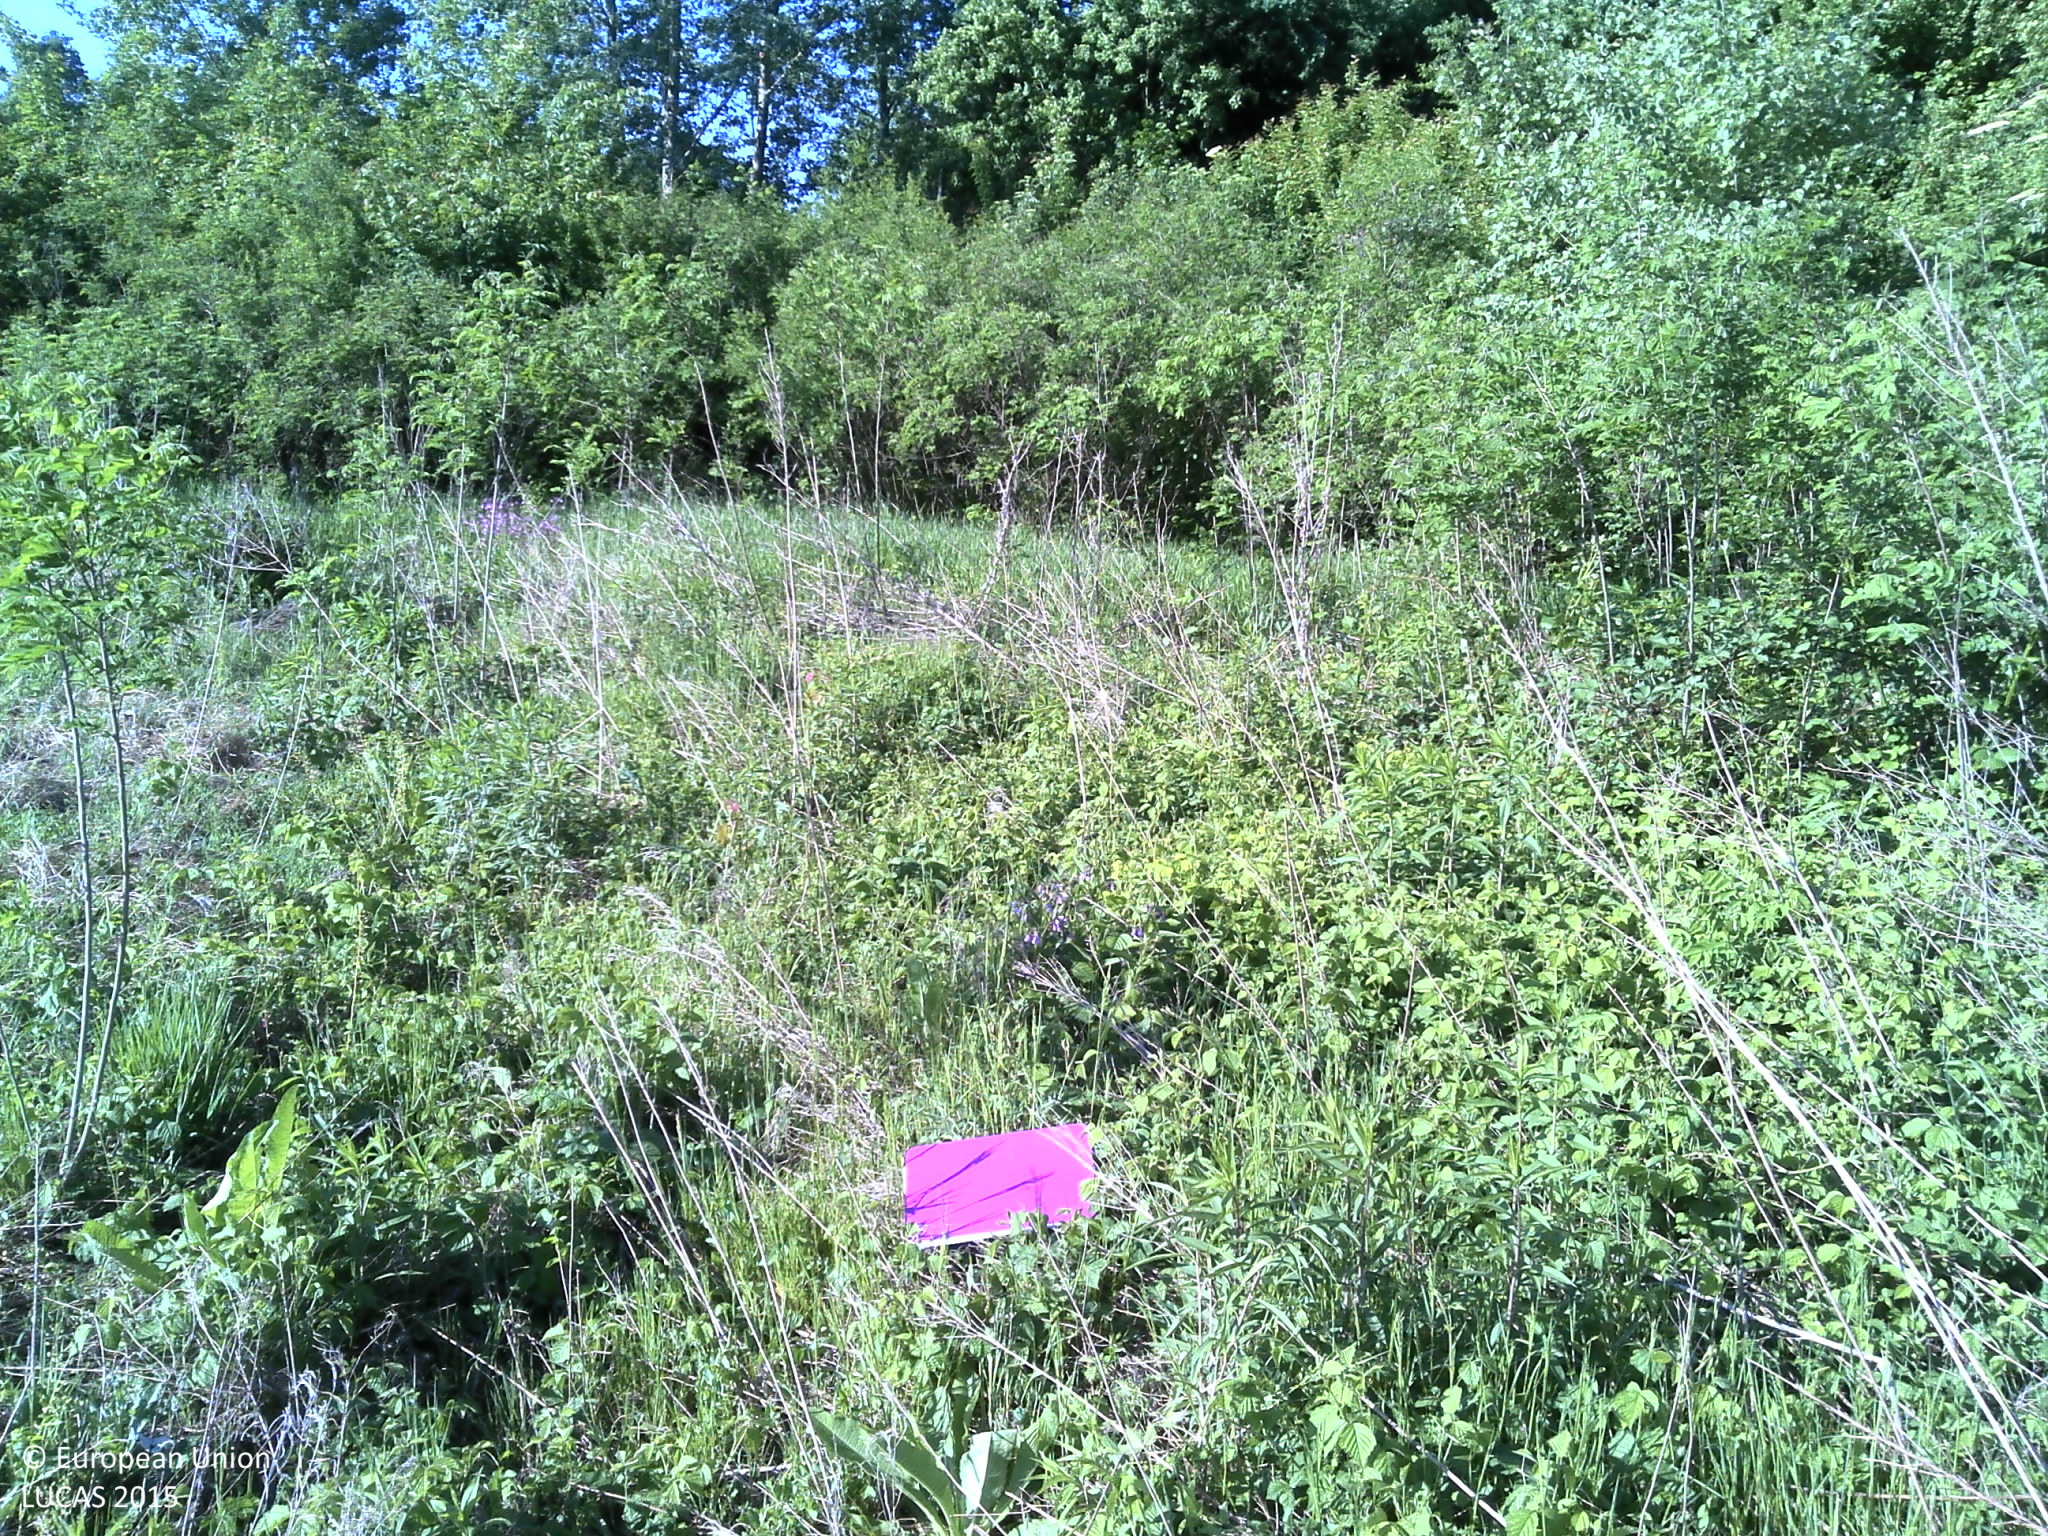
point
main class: Shrubland
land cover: Shrubland with sparse tree cover
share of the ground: > 75 %
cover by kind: shrubs 90 %, broadleaved forest trees 5 %, herbaceous plants 5 %
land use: Semi-natural and natural areas not in use
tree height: > 5 m
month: May
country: HR
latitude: 45.1302
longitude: 18.4342
